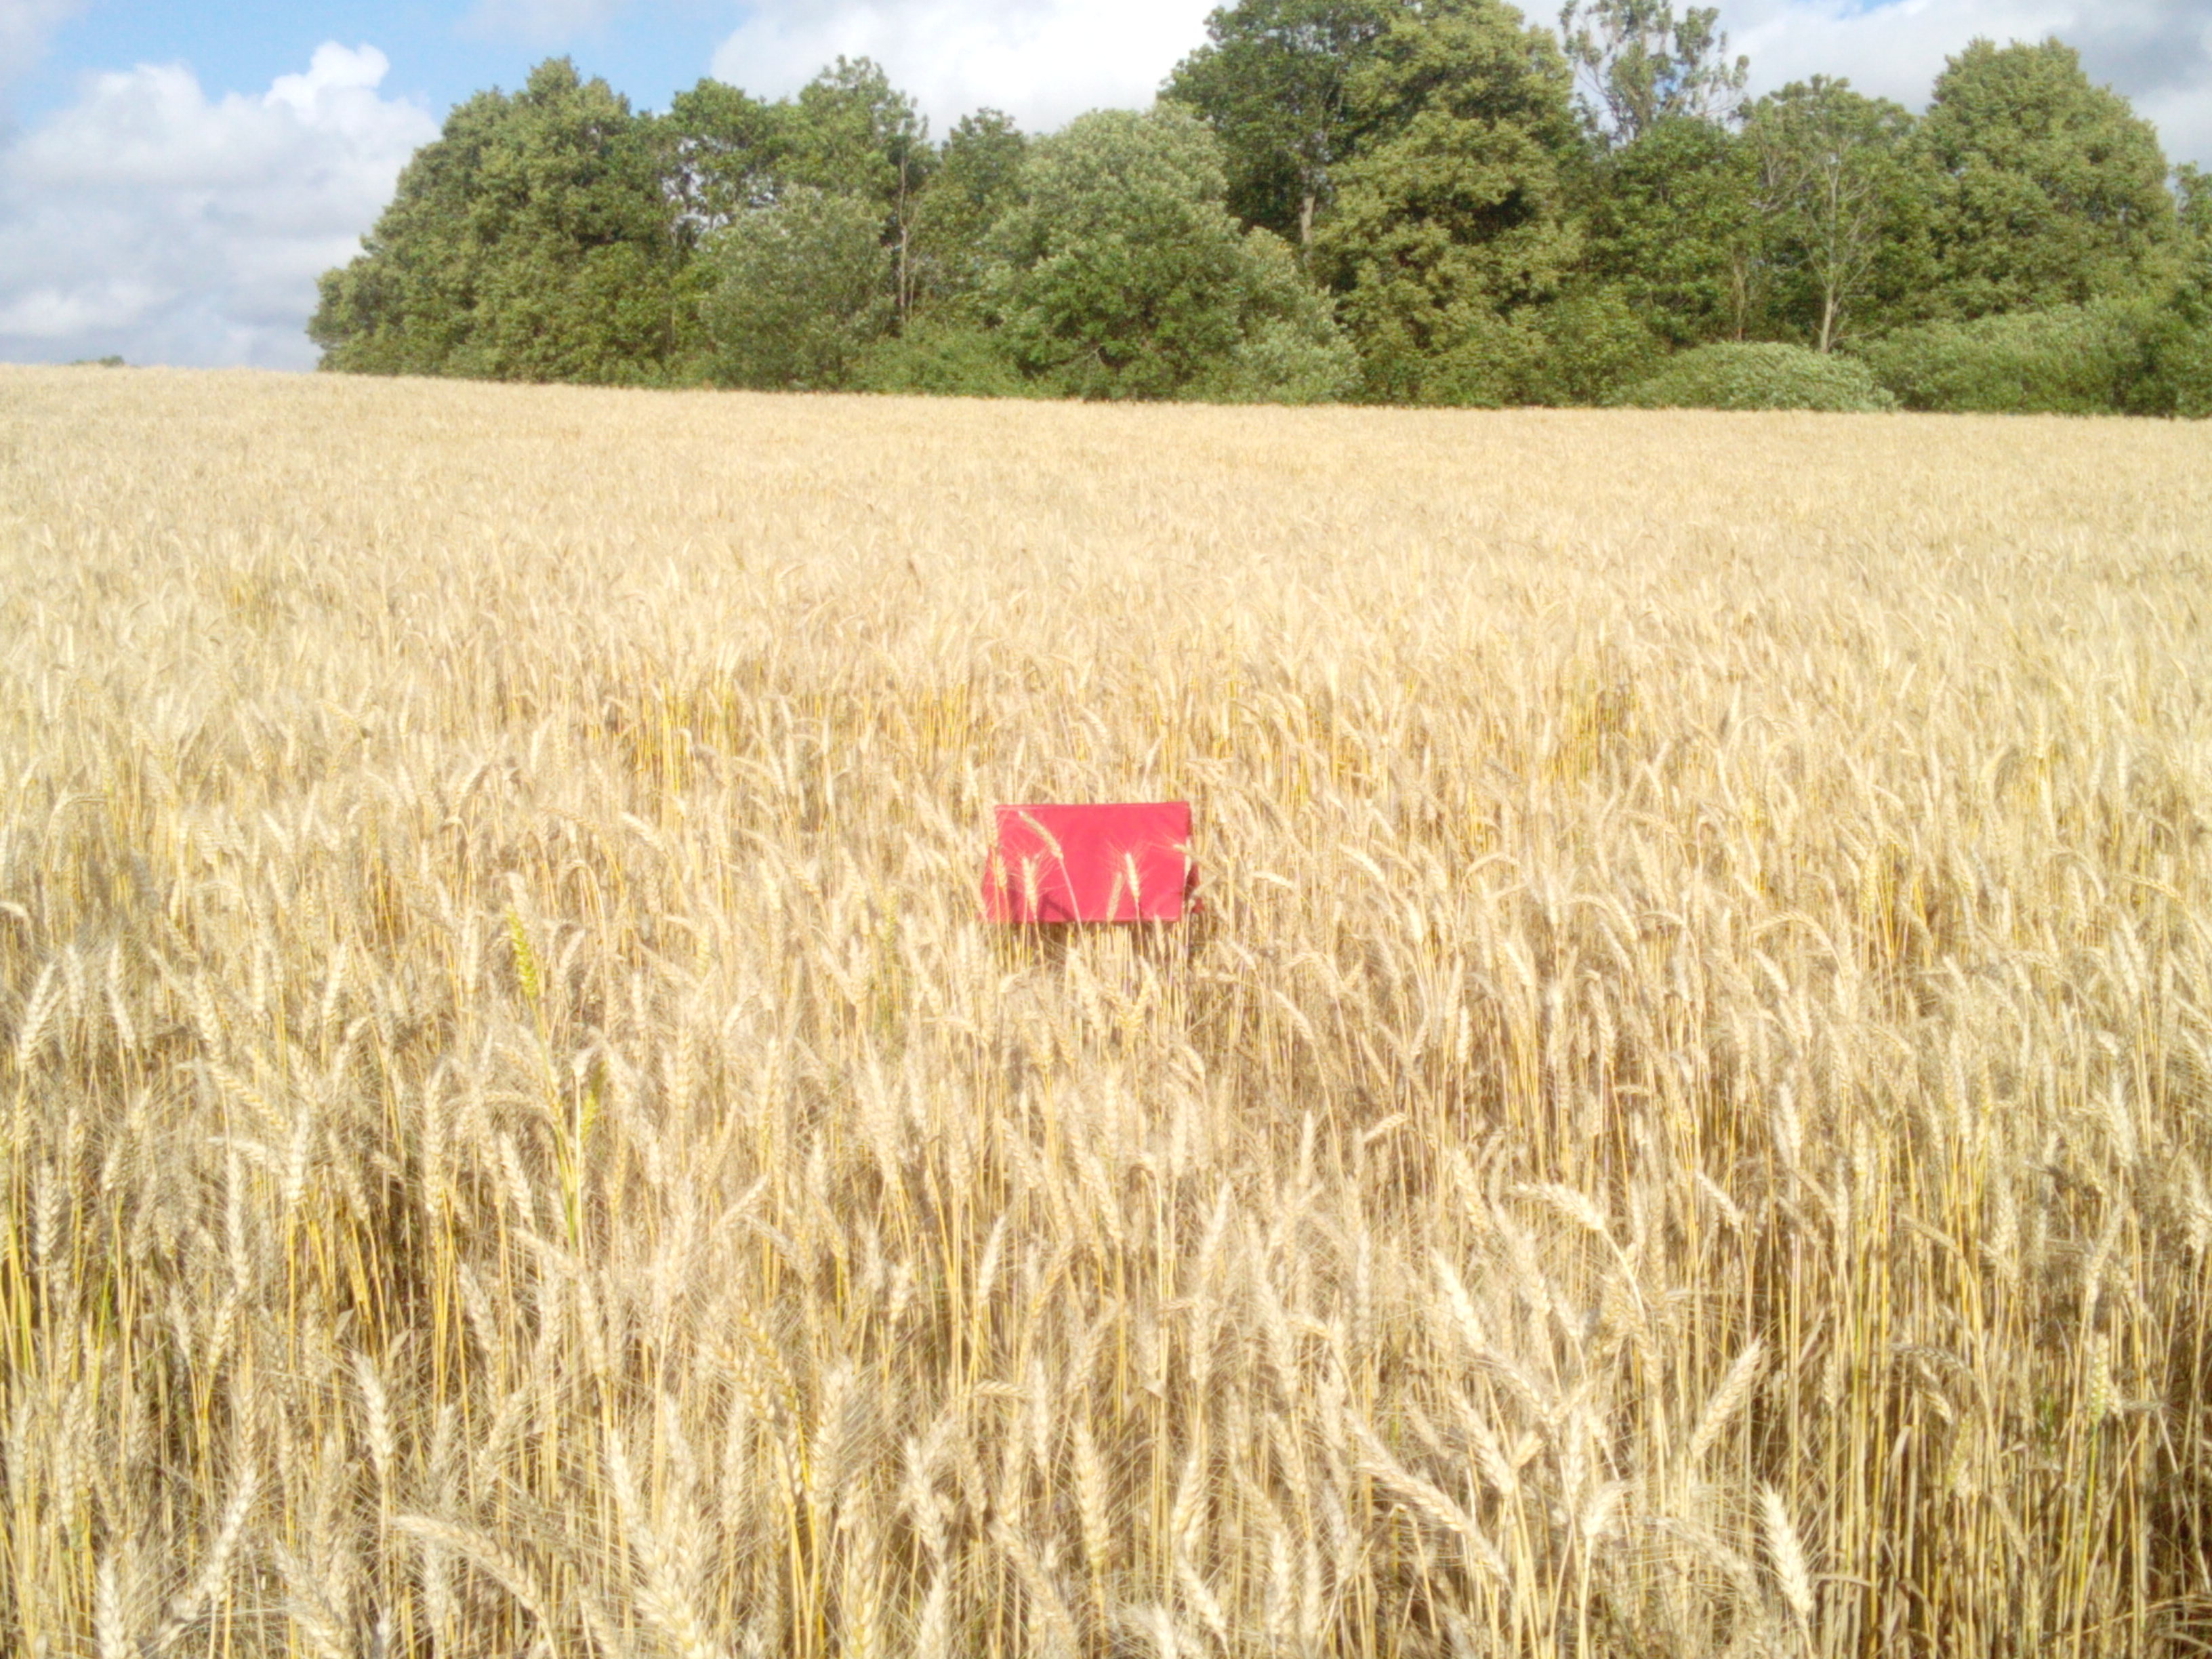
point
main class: Cropland
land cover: Common wheat
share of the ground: > 75 %
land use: Agriculture (excluding fallow land and kitchen gardens)
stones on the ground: 10 - 25 %
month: July
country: LV
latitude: 56.6494
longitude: 21.3090
